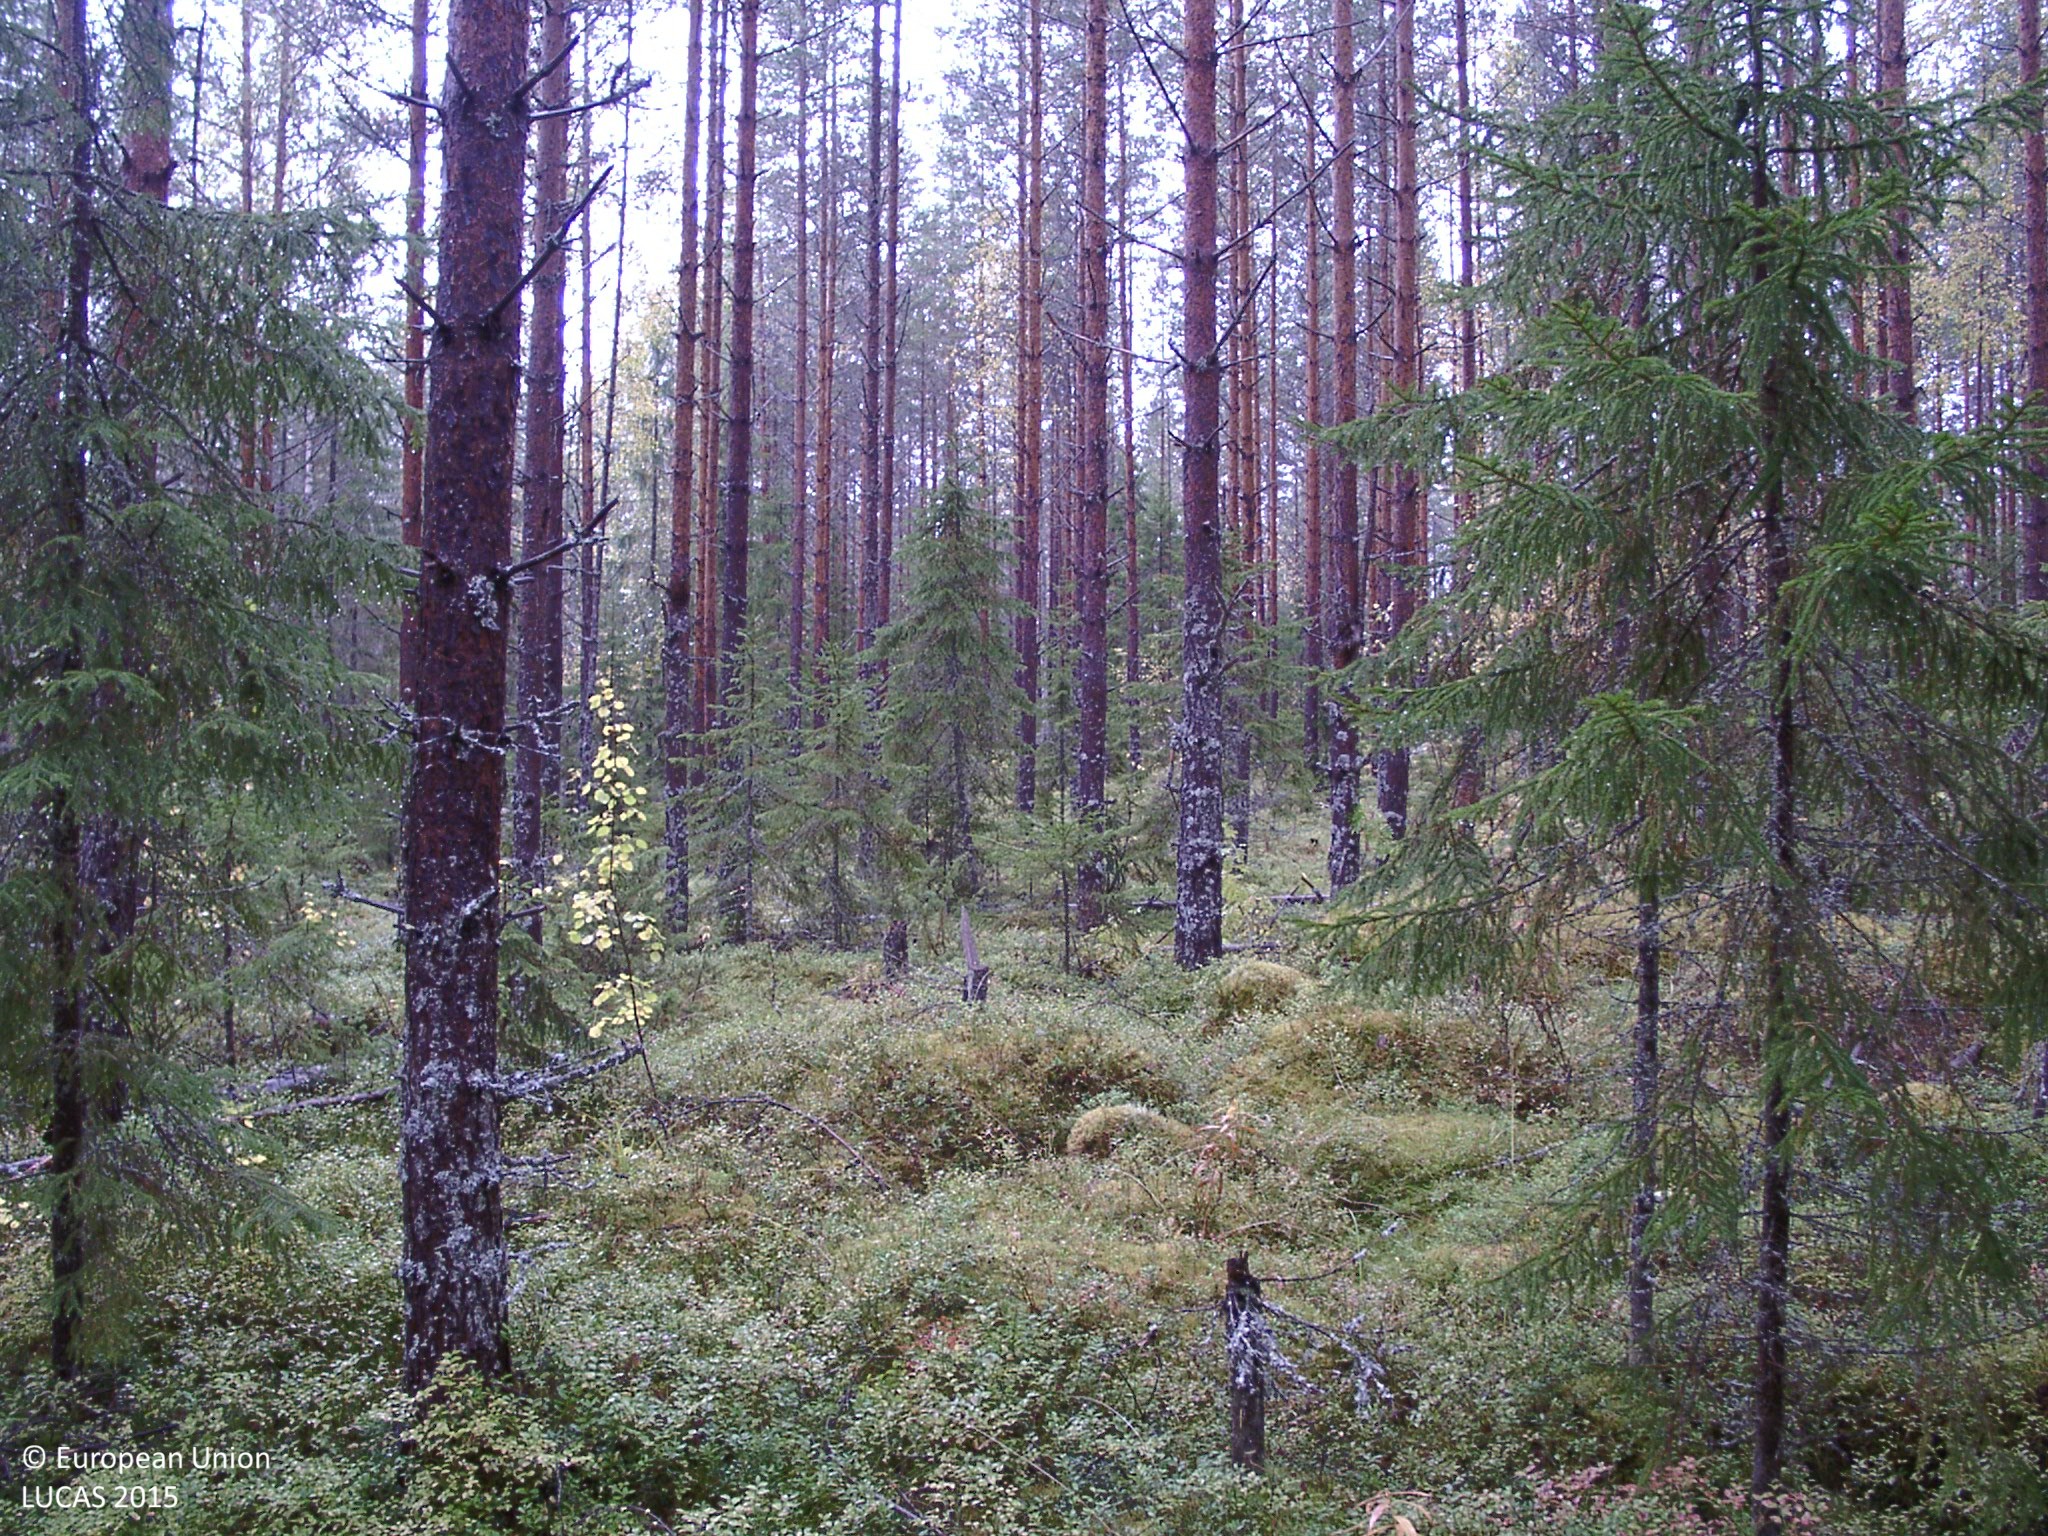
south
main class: Woodland
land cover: Other coniferous woodland
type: boreal forest
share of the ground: 50 - 75 %
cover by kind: coniferous forest trees 65 %, shrubs 15 %, lichens and mosses 15 %, herbaceous plants 5 %
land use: Forestry
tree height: > 5 m
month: September
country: FI
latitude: 62.7786
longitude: 25.6920
